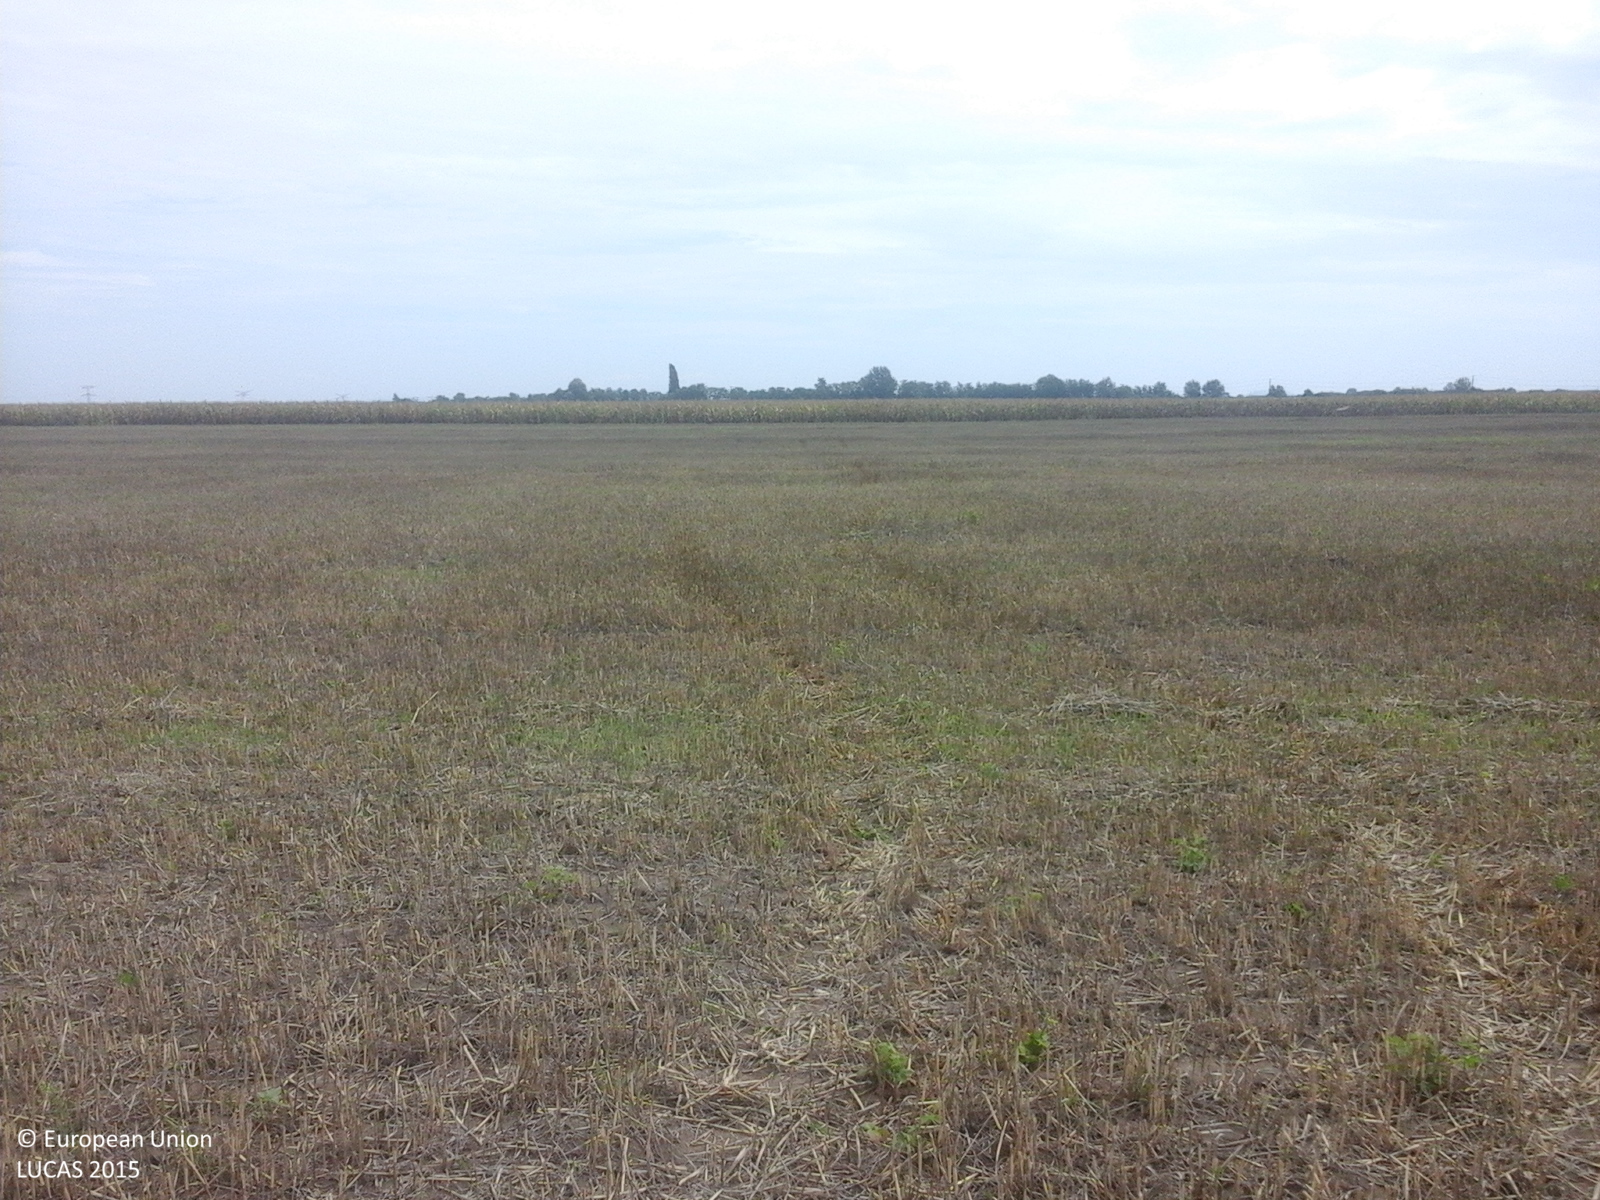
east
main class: Cropland
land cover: Common wheat
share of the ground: 25 - 50 %
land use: Agriculture (excluding fallow land and kitchen gardens)
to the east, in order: Common wheat; Maize; Sunflower; Maize; Sunflower
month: August
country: RO
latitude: 46.4608
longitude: 21.4564
